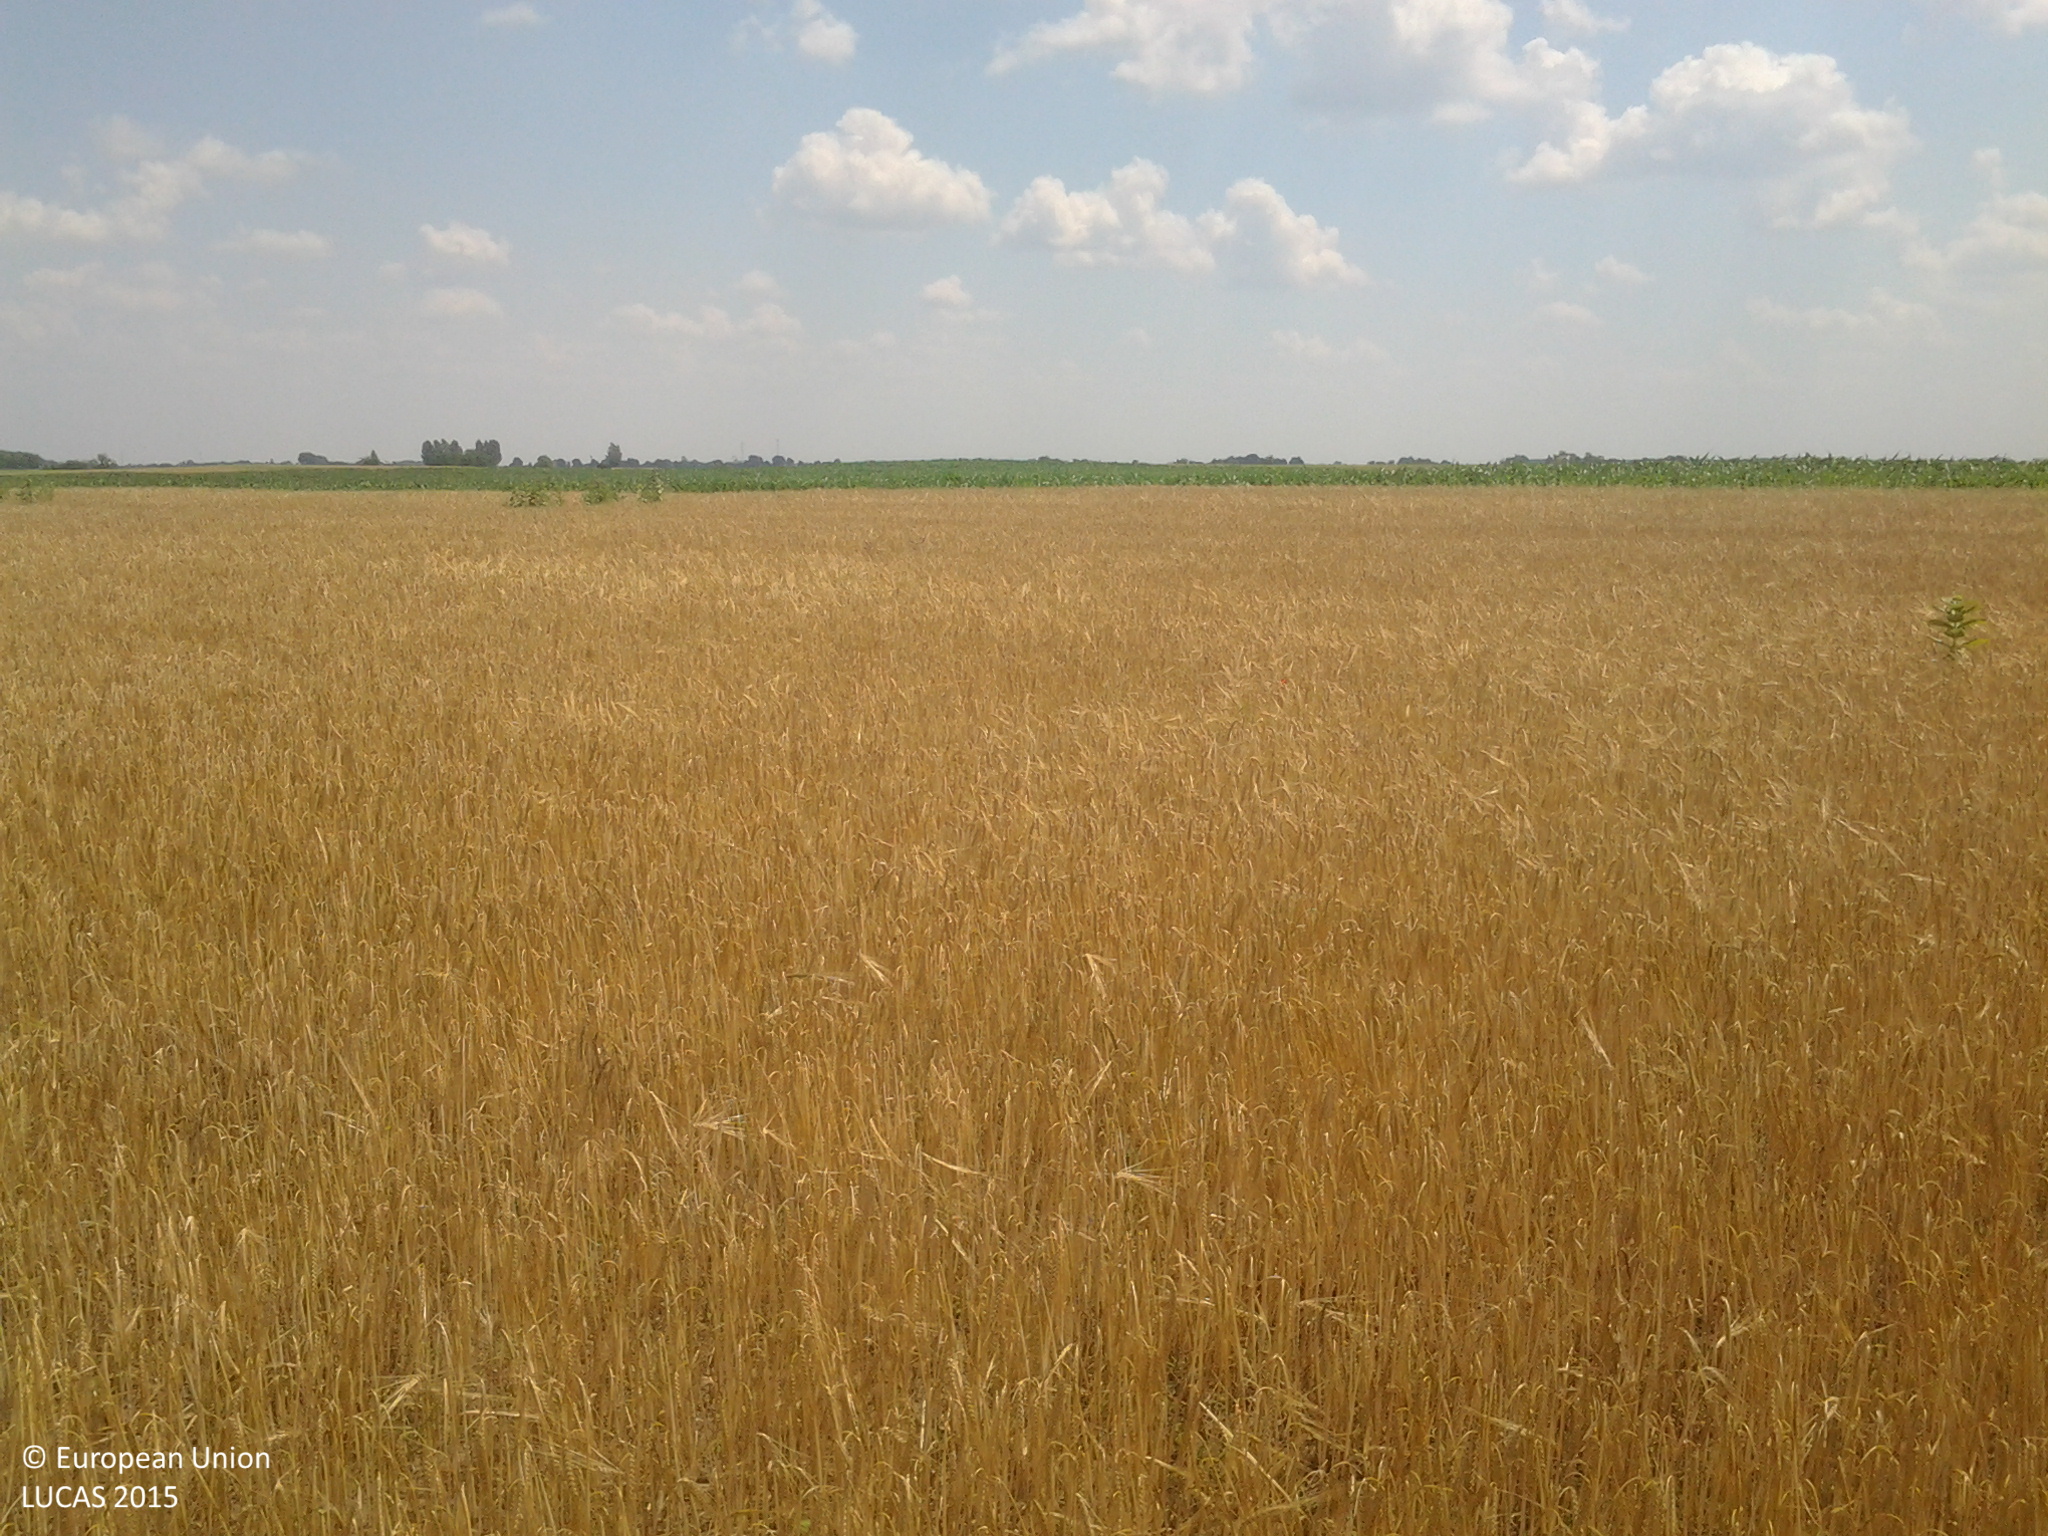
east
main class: Cropland
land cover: Barley
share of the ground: > 75 %
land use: Agriculture (excluding fallow land and kitchen gardens)
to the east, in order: Barley; Maize
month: June
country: HU
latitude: 46.8155
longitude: 19.7059
